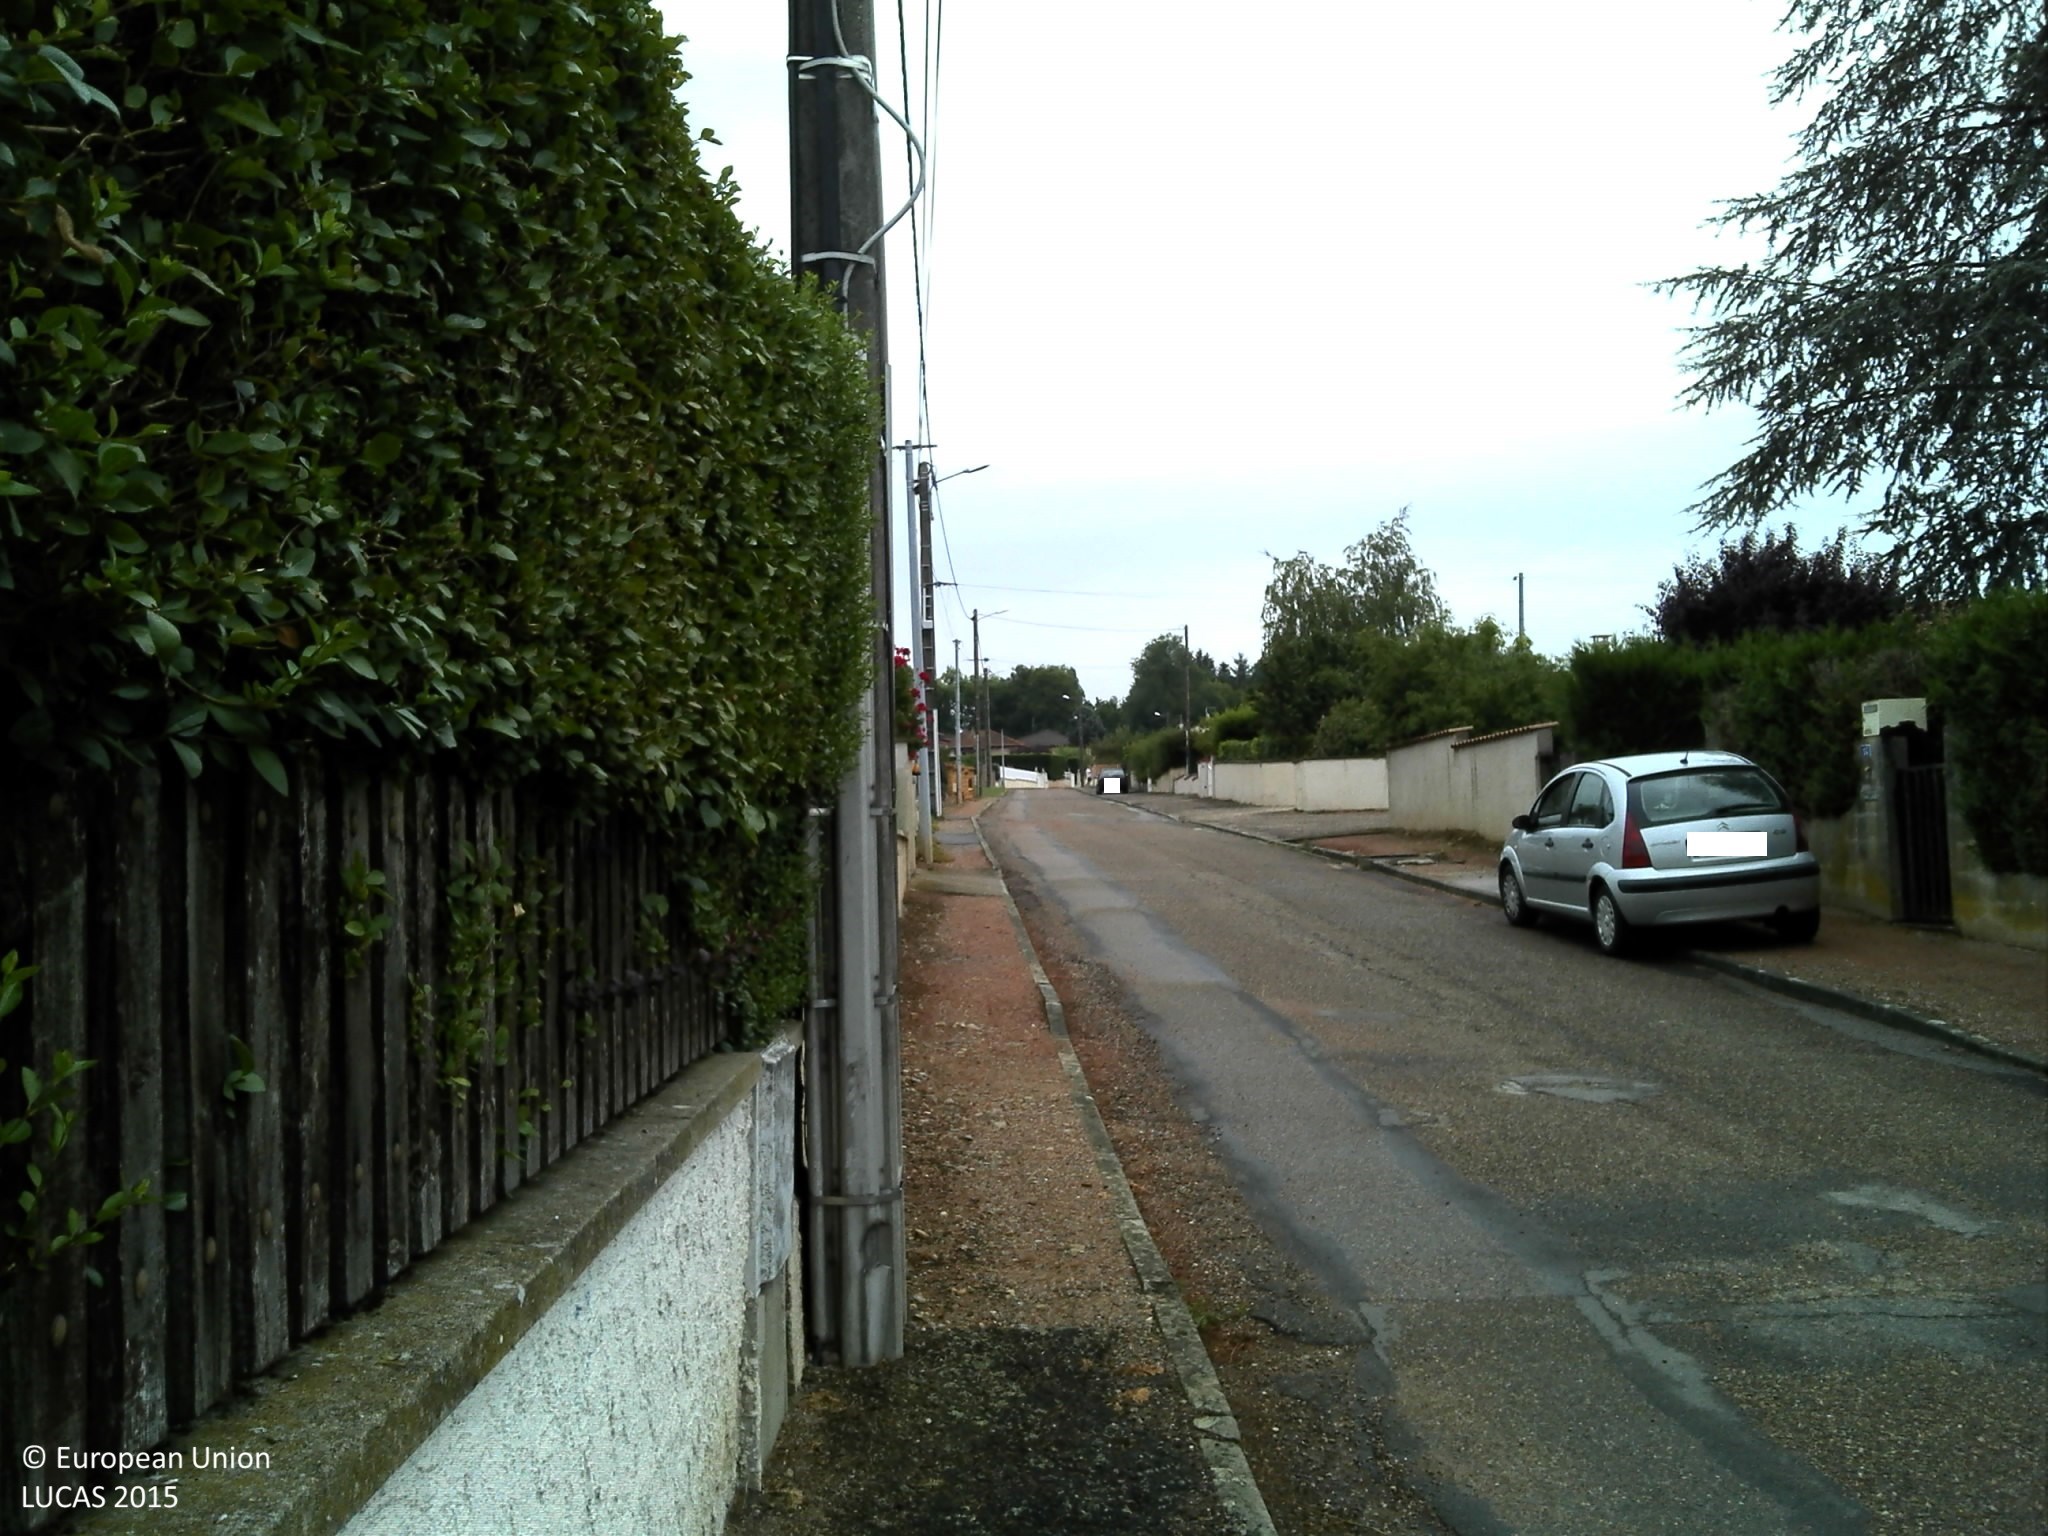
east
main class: Grassland
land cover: Grassland without tree/shrub cover
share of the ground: > 75 %
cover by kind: herbaceous plants 100 %
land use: Residential
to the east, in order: Grassland without tree/shrub cover; Artificial constructions in urban areas
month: August
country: FR
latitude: 46.1514
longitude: 4.0842
